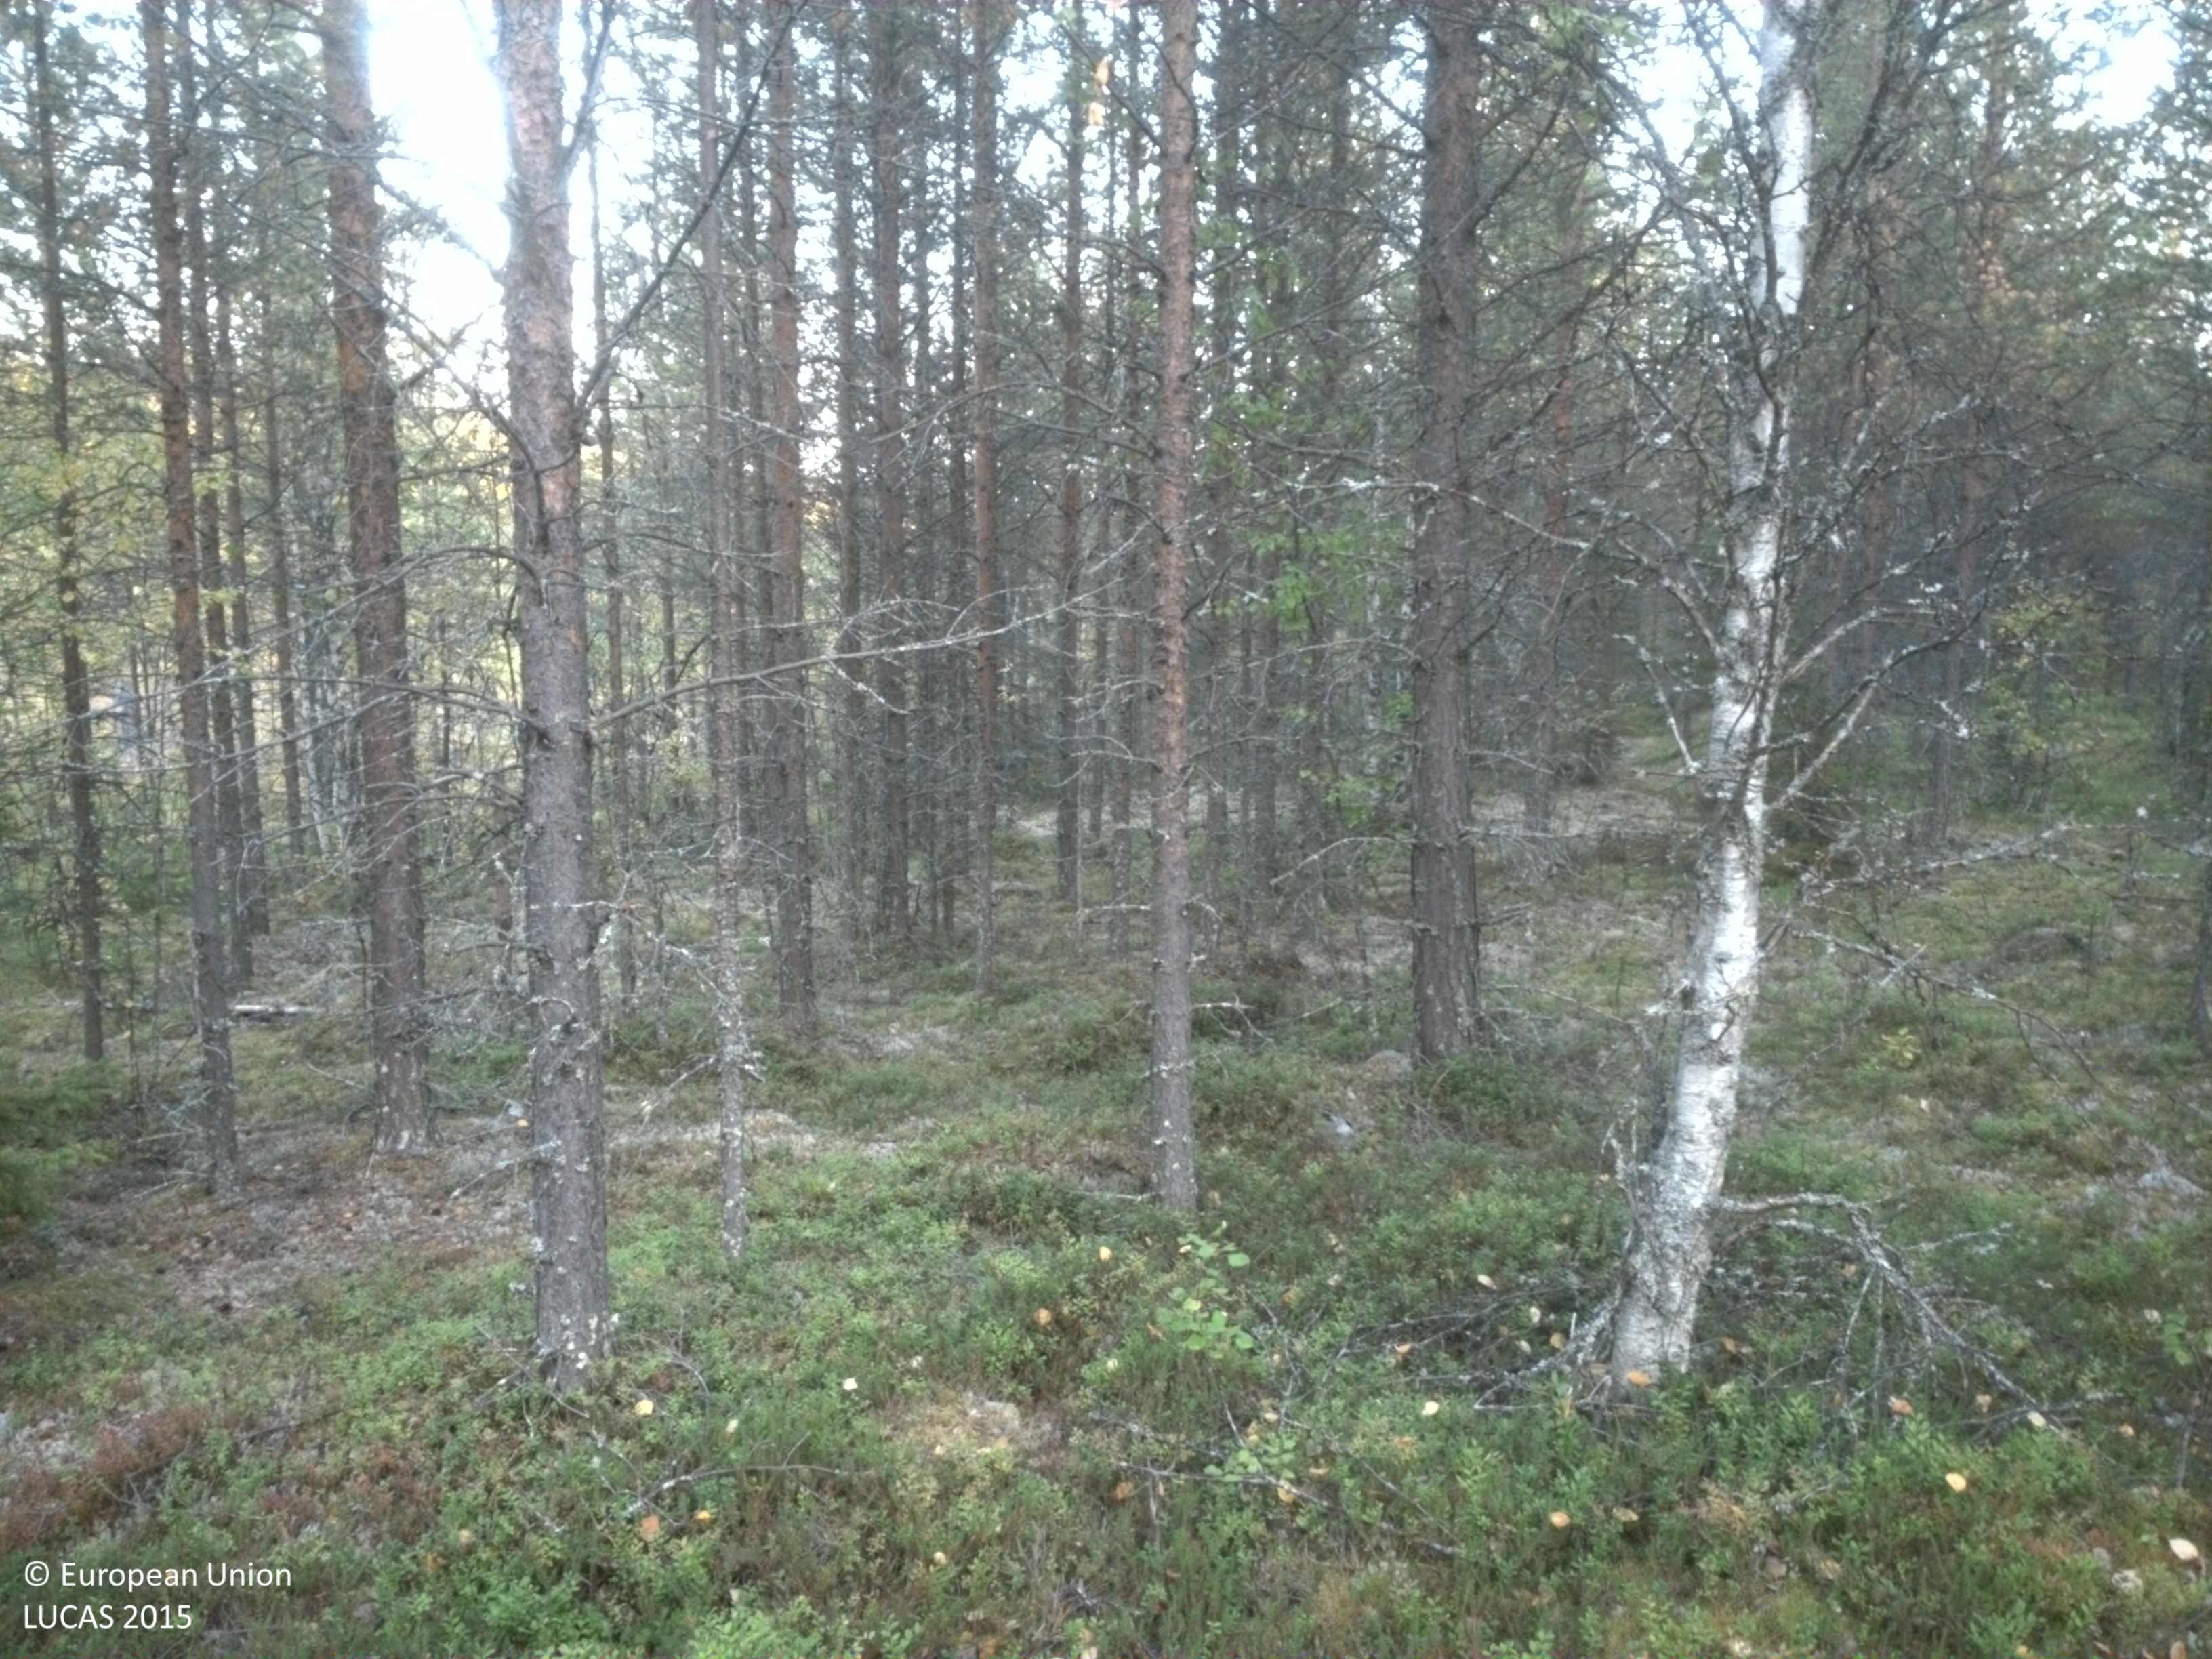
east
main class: Woodland
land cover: Pine dominated coniferous woodland
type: boreal forest
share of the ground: 25 - 50 %
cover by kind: coniferous forest trees 40 %, lichens and mosses 25 %, shrubs 20 %, herbaceous plants 10 %, broadleaved forest trees 5 %
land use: Forestry
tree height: > 5 m
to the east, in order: Pine dominated coniferous woodland; Pine dominated mixed woodland; Broadleaved woodland; Shrubland with sparse tree cover; Paved roads, cycling and walking lanes; Shrubland with sparse tree cover; Pine dominated mixed woodland
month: September
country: SE
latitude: 64.4280
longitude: 20.0037
